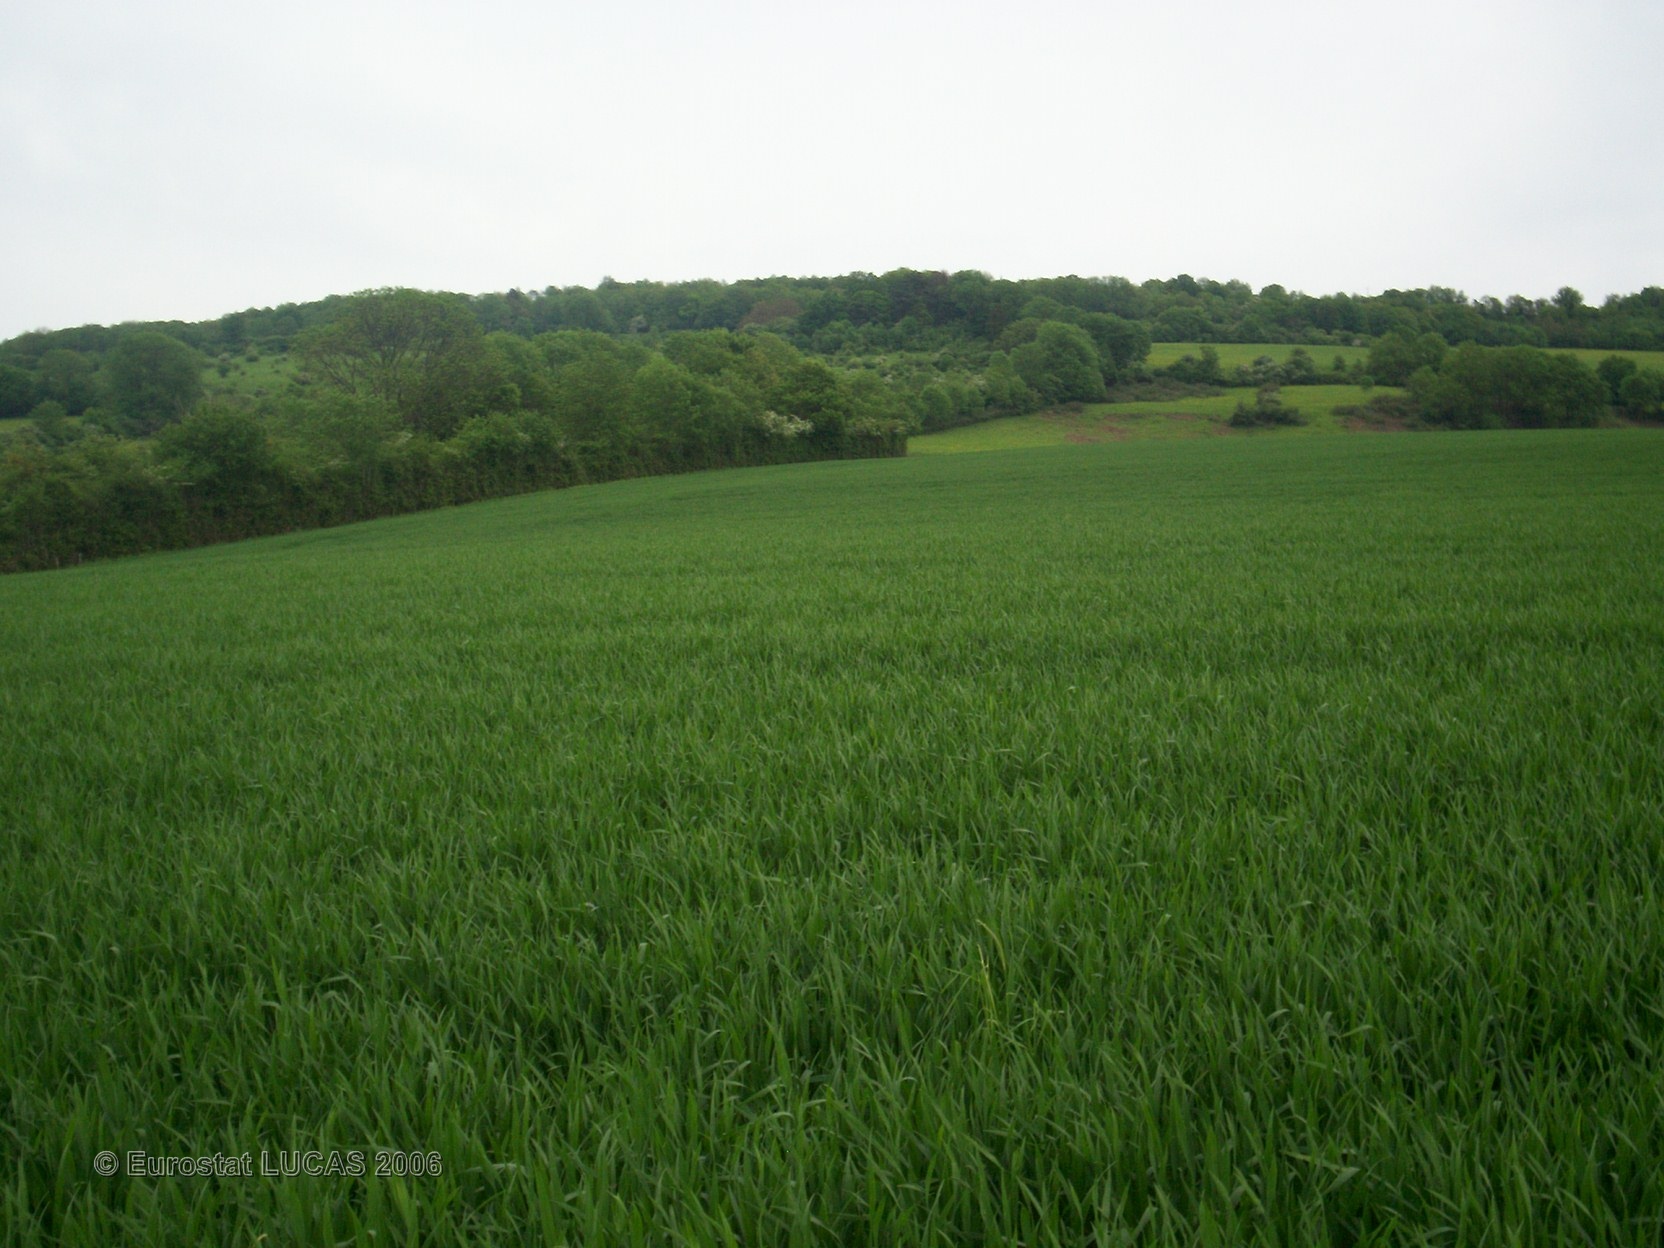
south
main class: Cropland
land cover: Common wheat
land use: Agriculture (excluding fallow land and kitchen gardens)
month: May
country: FR
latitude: 47.2459
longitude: 4.6492
